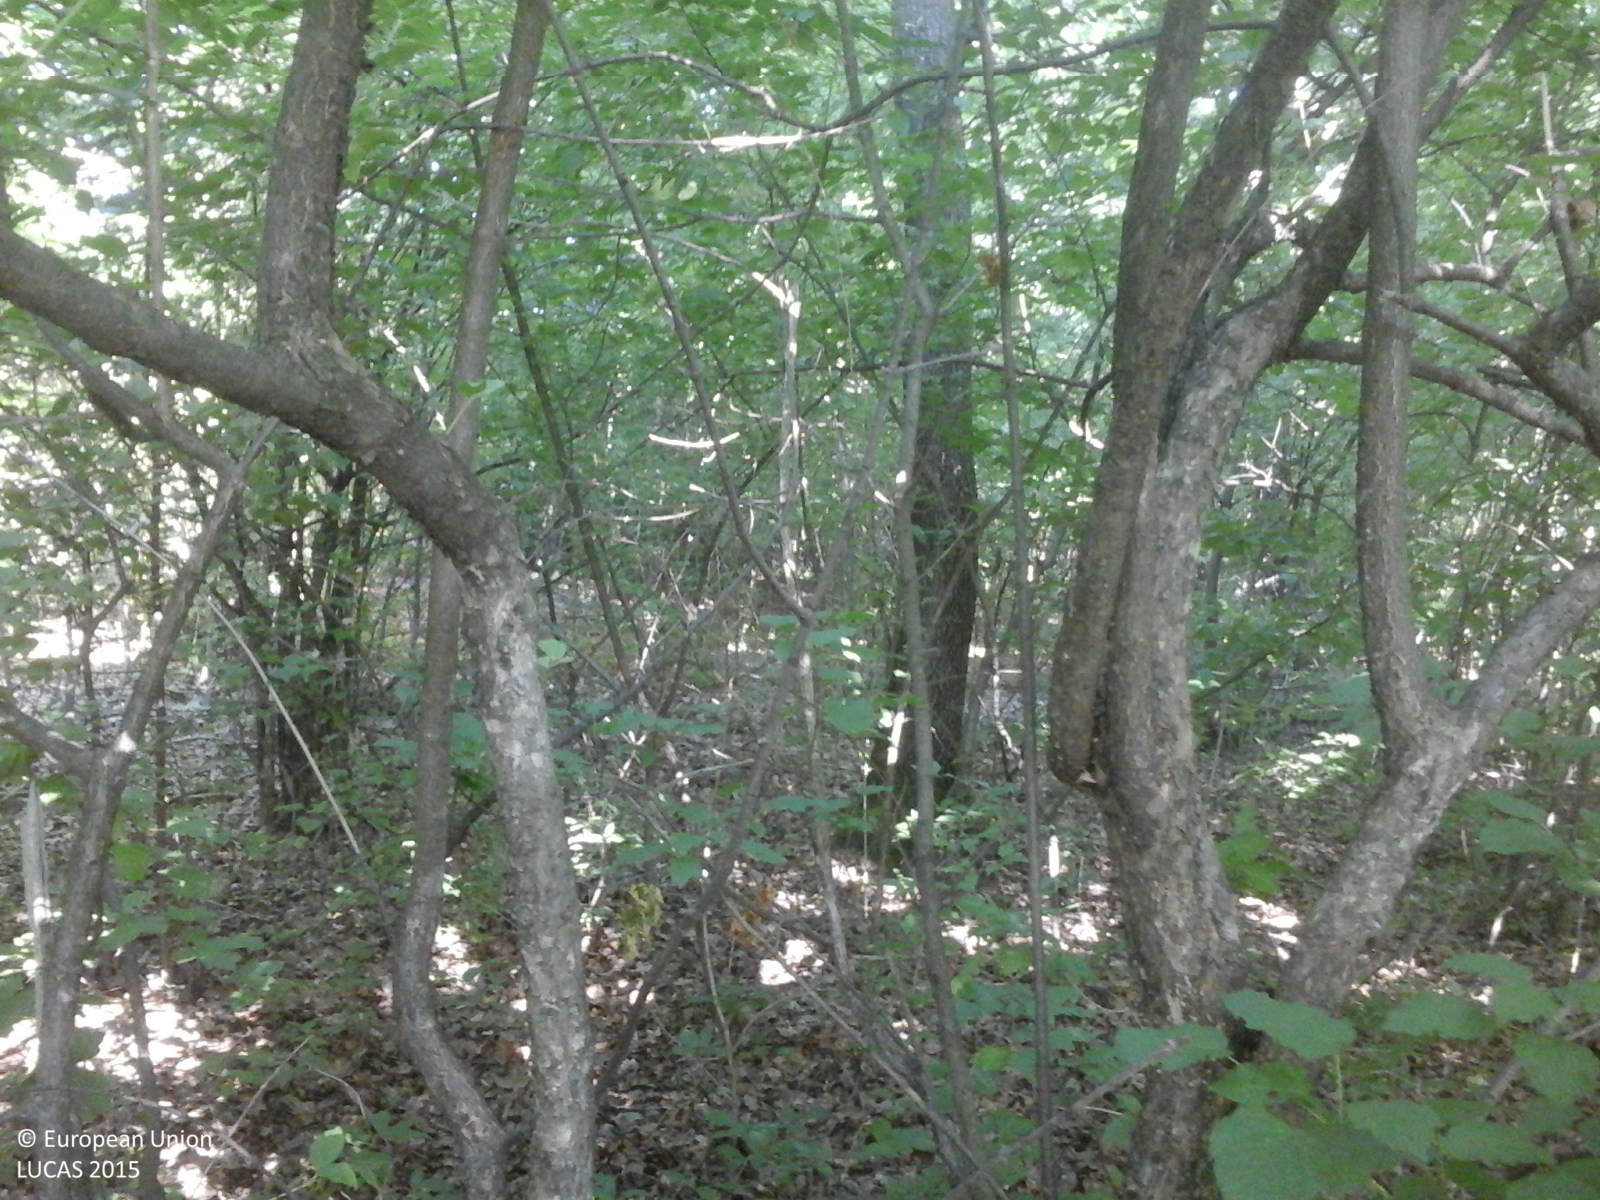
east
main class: Woodland
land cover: Broadleaved woodland
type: acidophilous oak and oak-birch forest
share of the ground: > 75 %
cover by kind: broadleaved forest trees 100 %
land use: Forestry
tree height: > 5 m
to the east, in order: Broadleaved woodland; Grassland with sparse tree/shrub cover; Abandoned hedges; Grassland with sparse tree/shrub cover; Abandoned hedges; Tracks; Abandoned hedges; Grassland with sparse tree/shrub cover; Broadleaved woodland; Grassland with sparse tree/shrub cover; Broadleaved woodland
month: June
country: RO
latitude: 45.1208
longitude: 26.2217
